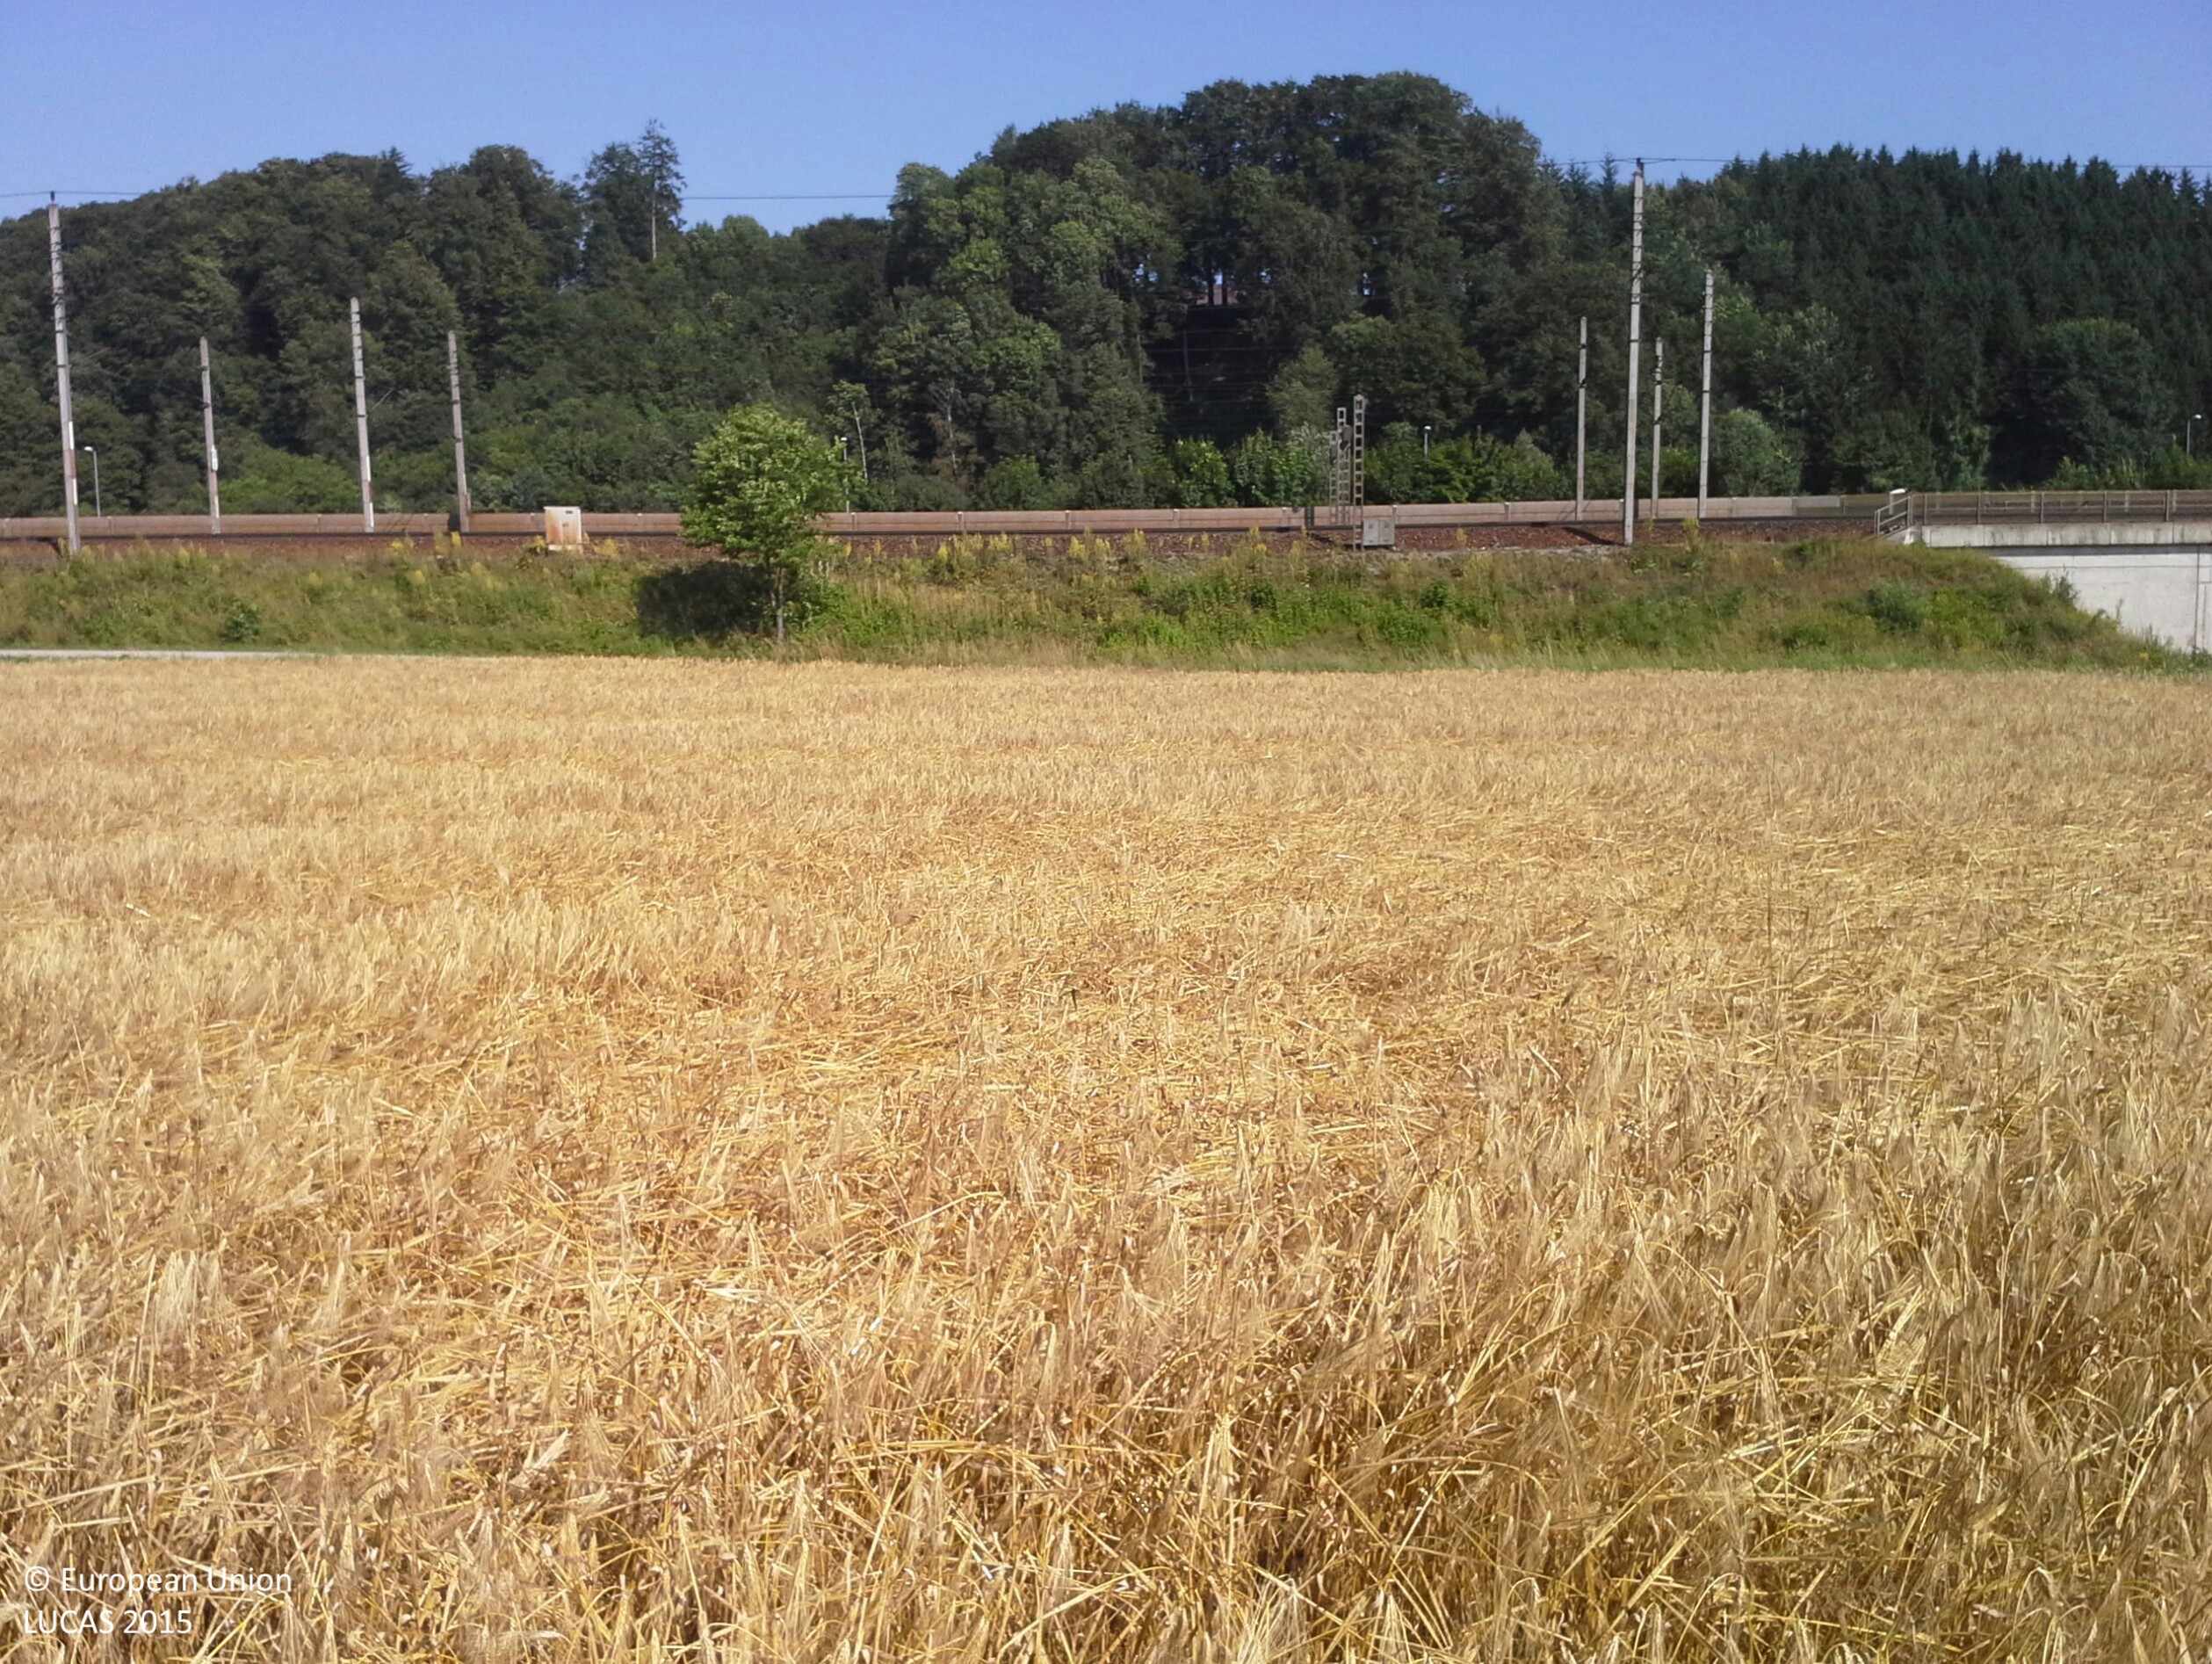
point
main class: Cropland
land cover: Barley
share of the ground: > 75 %
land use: Agriculture (excluding fallow land and kitchen gardens)
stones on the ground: 25 - 50 %
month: July
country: AT
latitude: 48.1168
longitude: 14.8500
